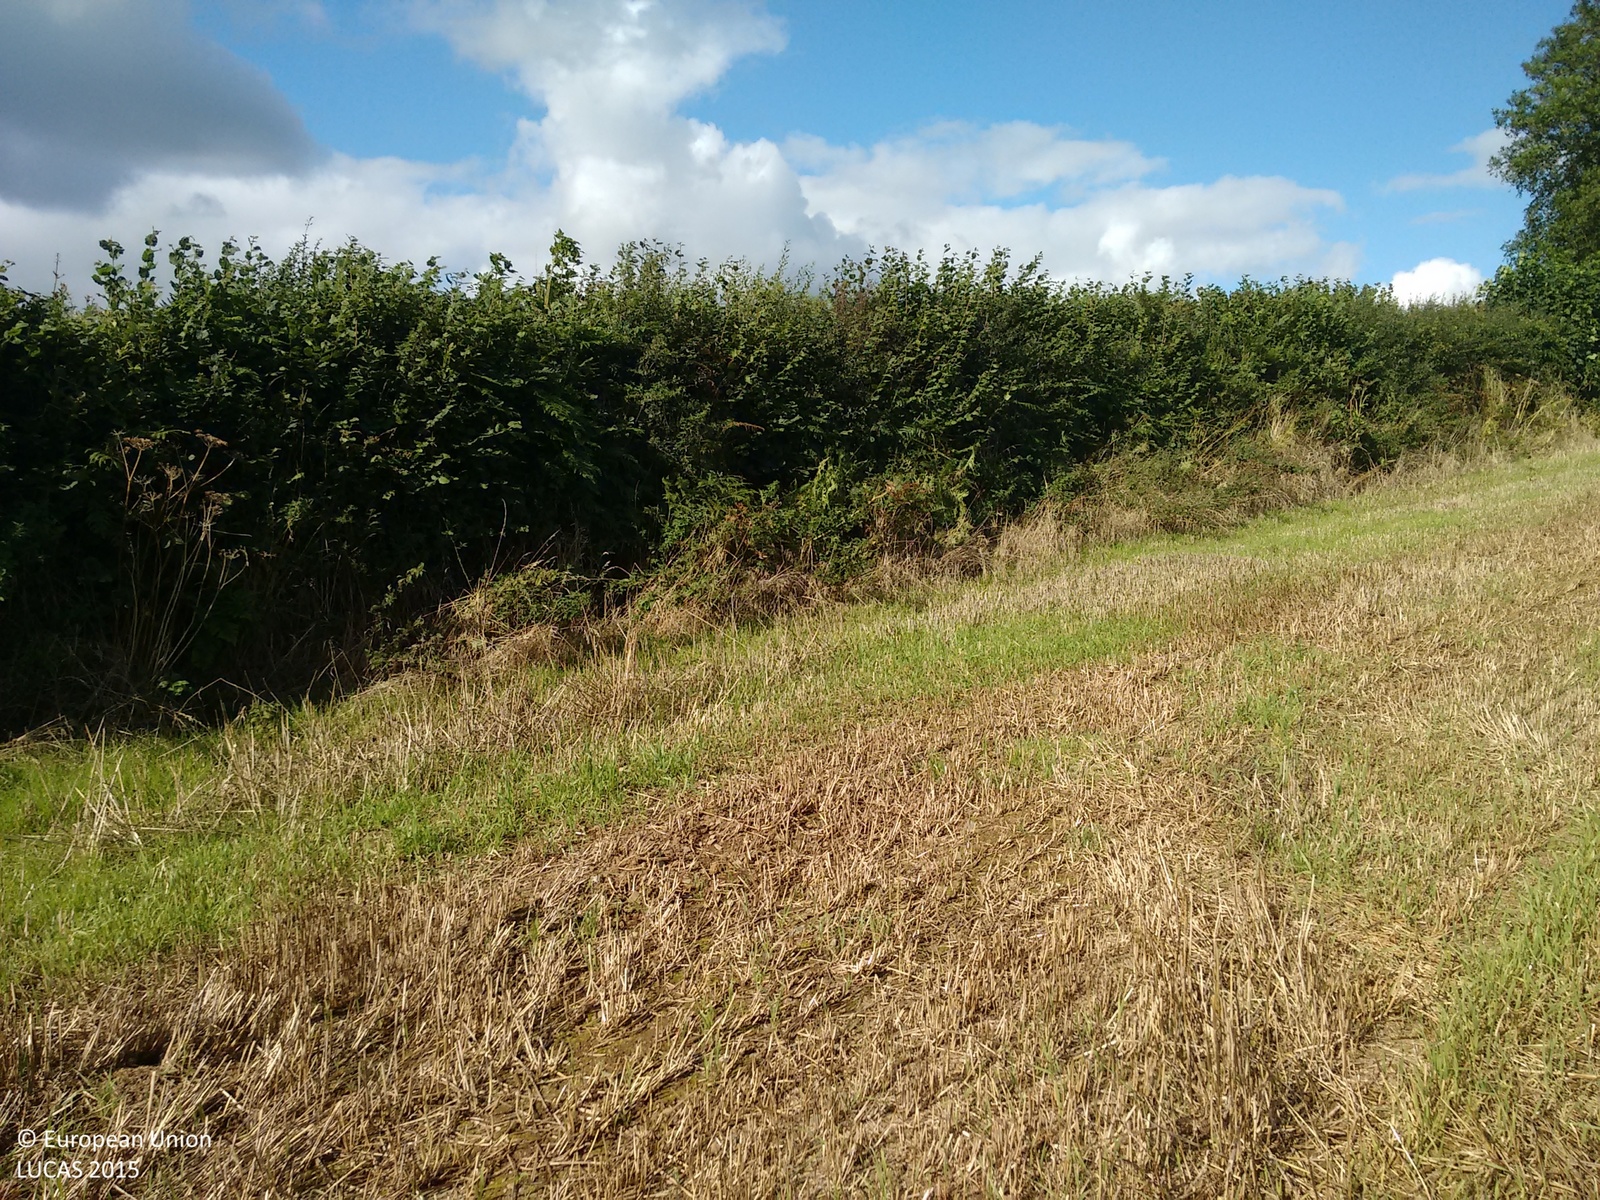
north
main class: Cropland
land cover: Common wheat
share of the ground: 10 - 25 %
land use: Agriculture (excluding fallow land and kitchen gardens)
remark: Harvested field
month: September
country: GB
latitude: 50.5573
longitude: -4.4301
